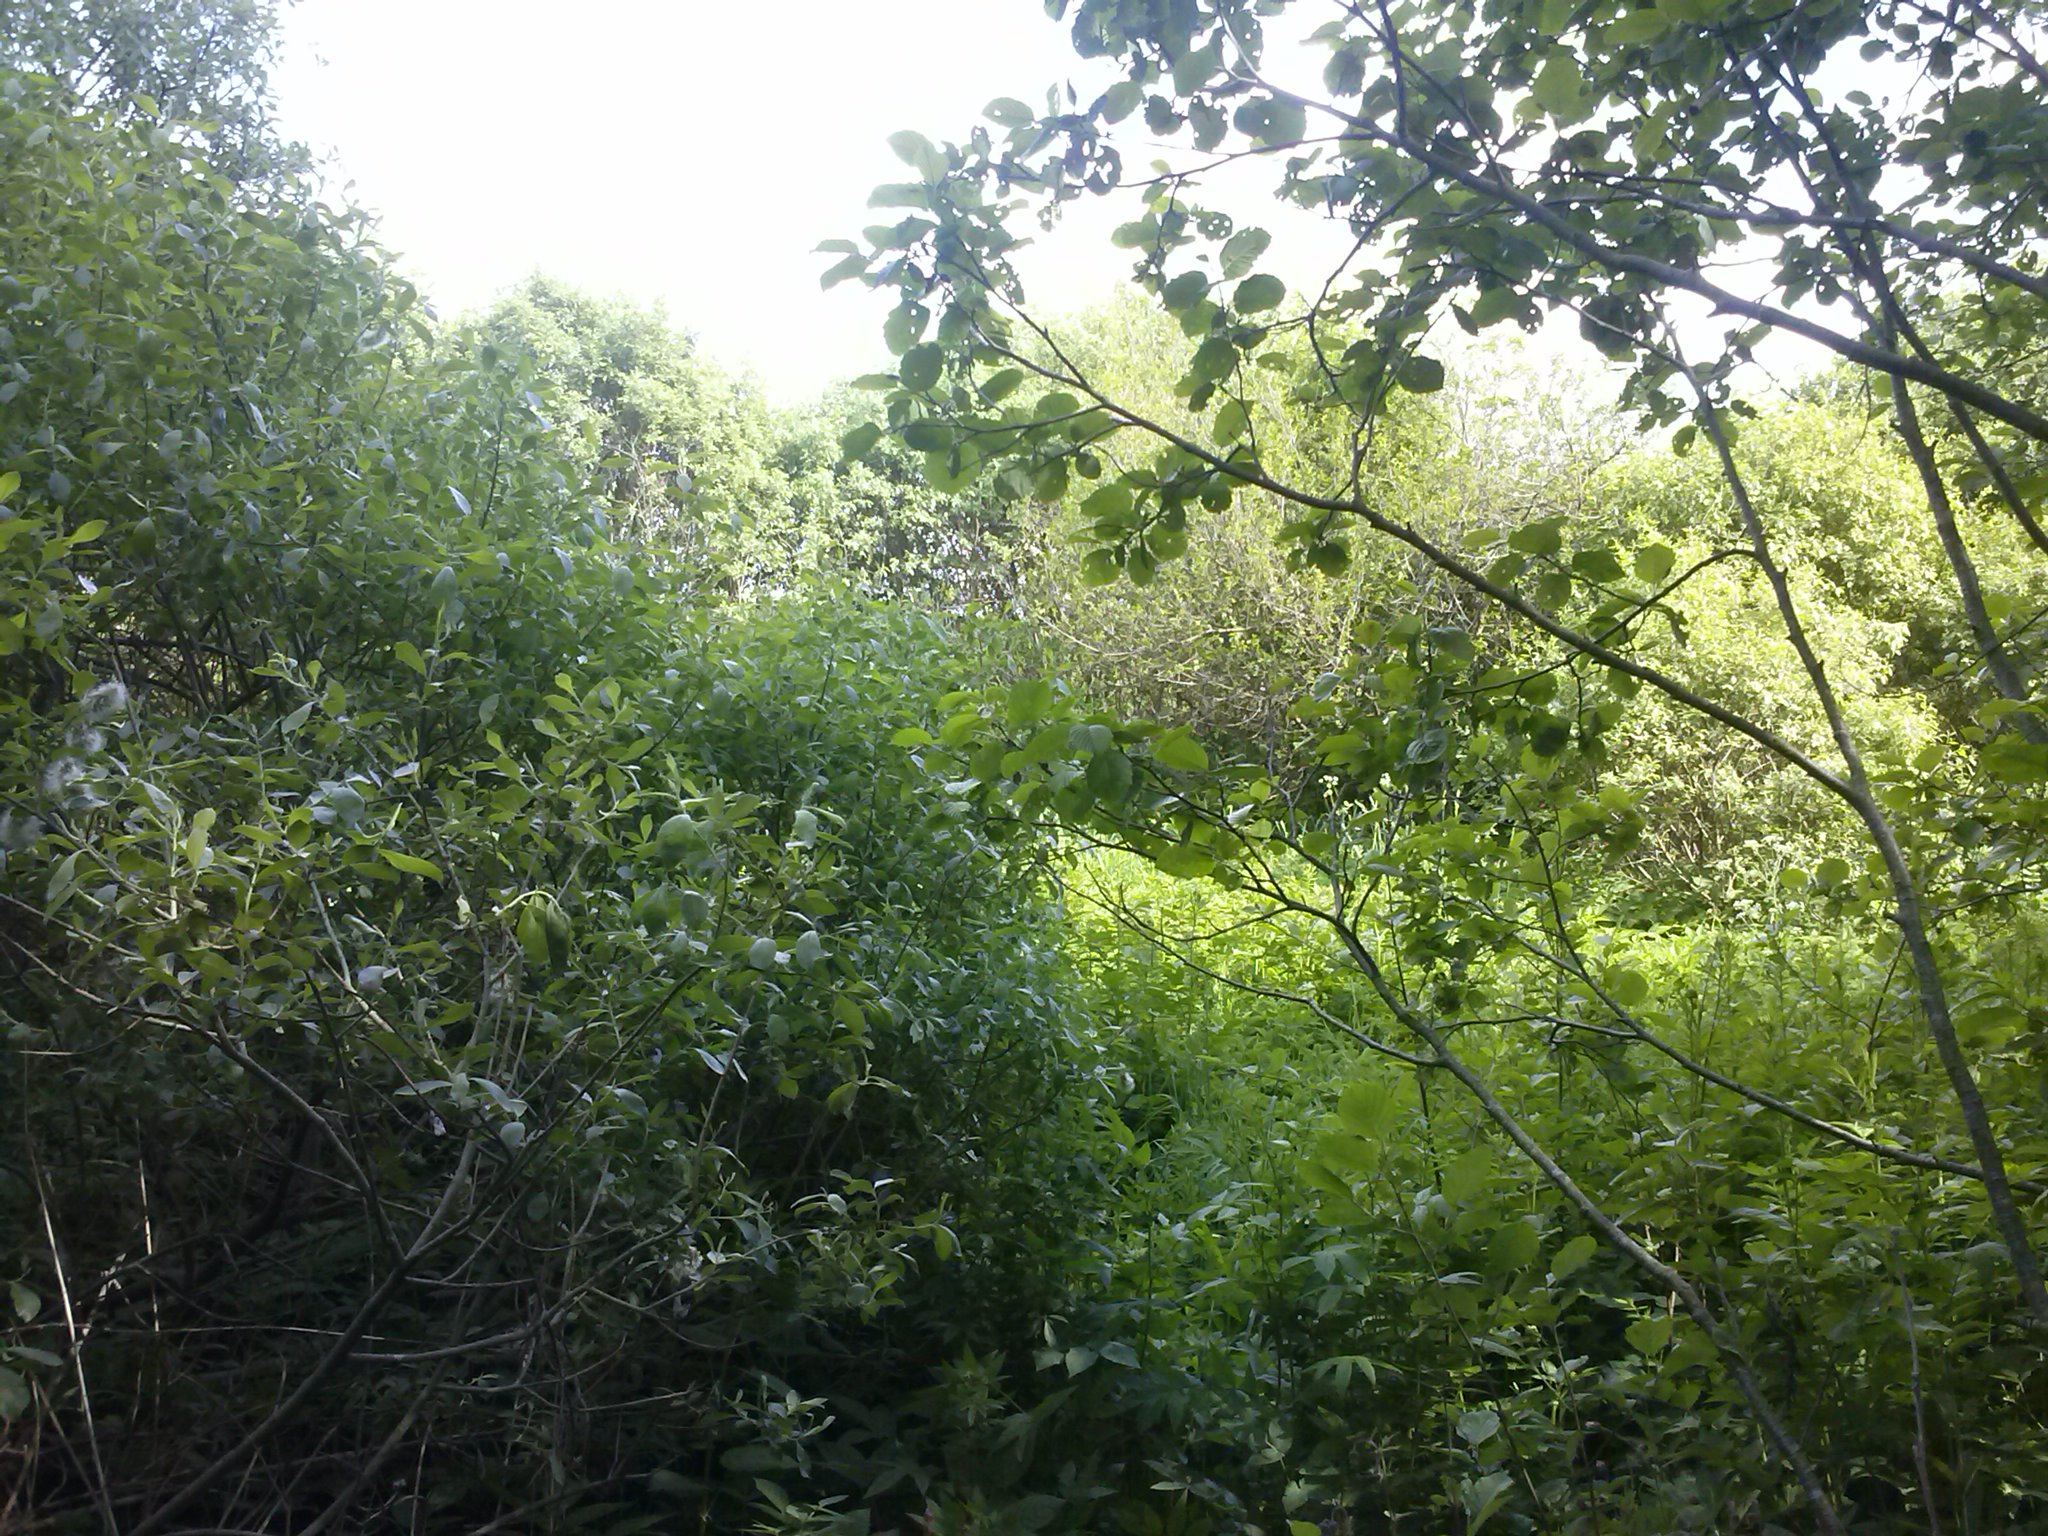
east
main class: Woodland
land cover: Broadleaved woodland
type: non-riverine alder, birch or aspen forest
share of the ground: > 75 %
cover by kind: broadleaved forest trees 100 %
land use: Forestry
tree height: > 5 m
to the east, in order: Broadleaved woodland; Spontaneously vegetated surfaces; Grassland without tree/shrub cover; Broadleaved woodland; Spontaneously vegetated surfaces
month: June
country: LV
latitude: 56.3036
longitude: 26.7879
